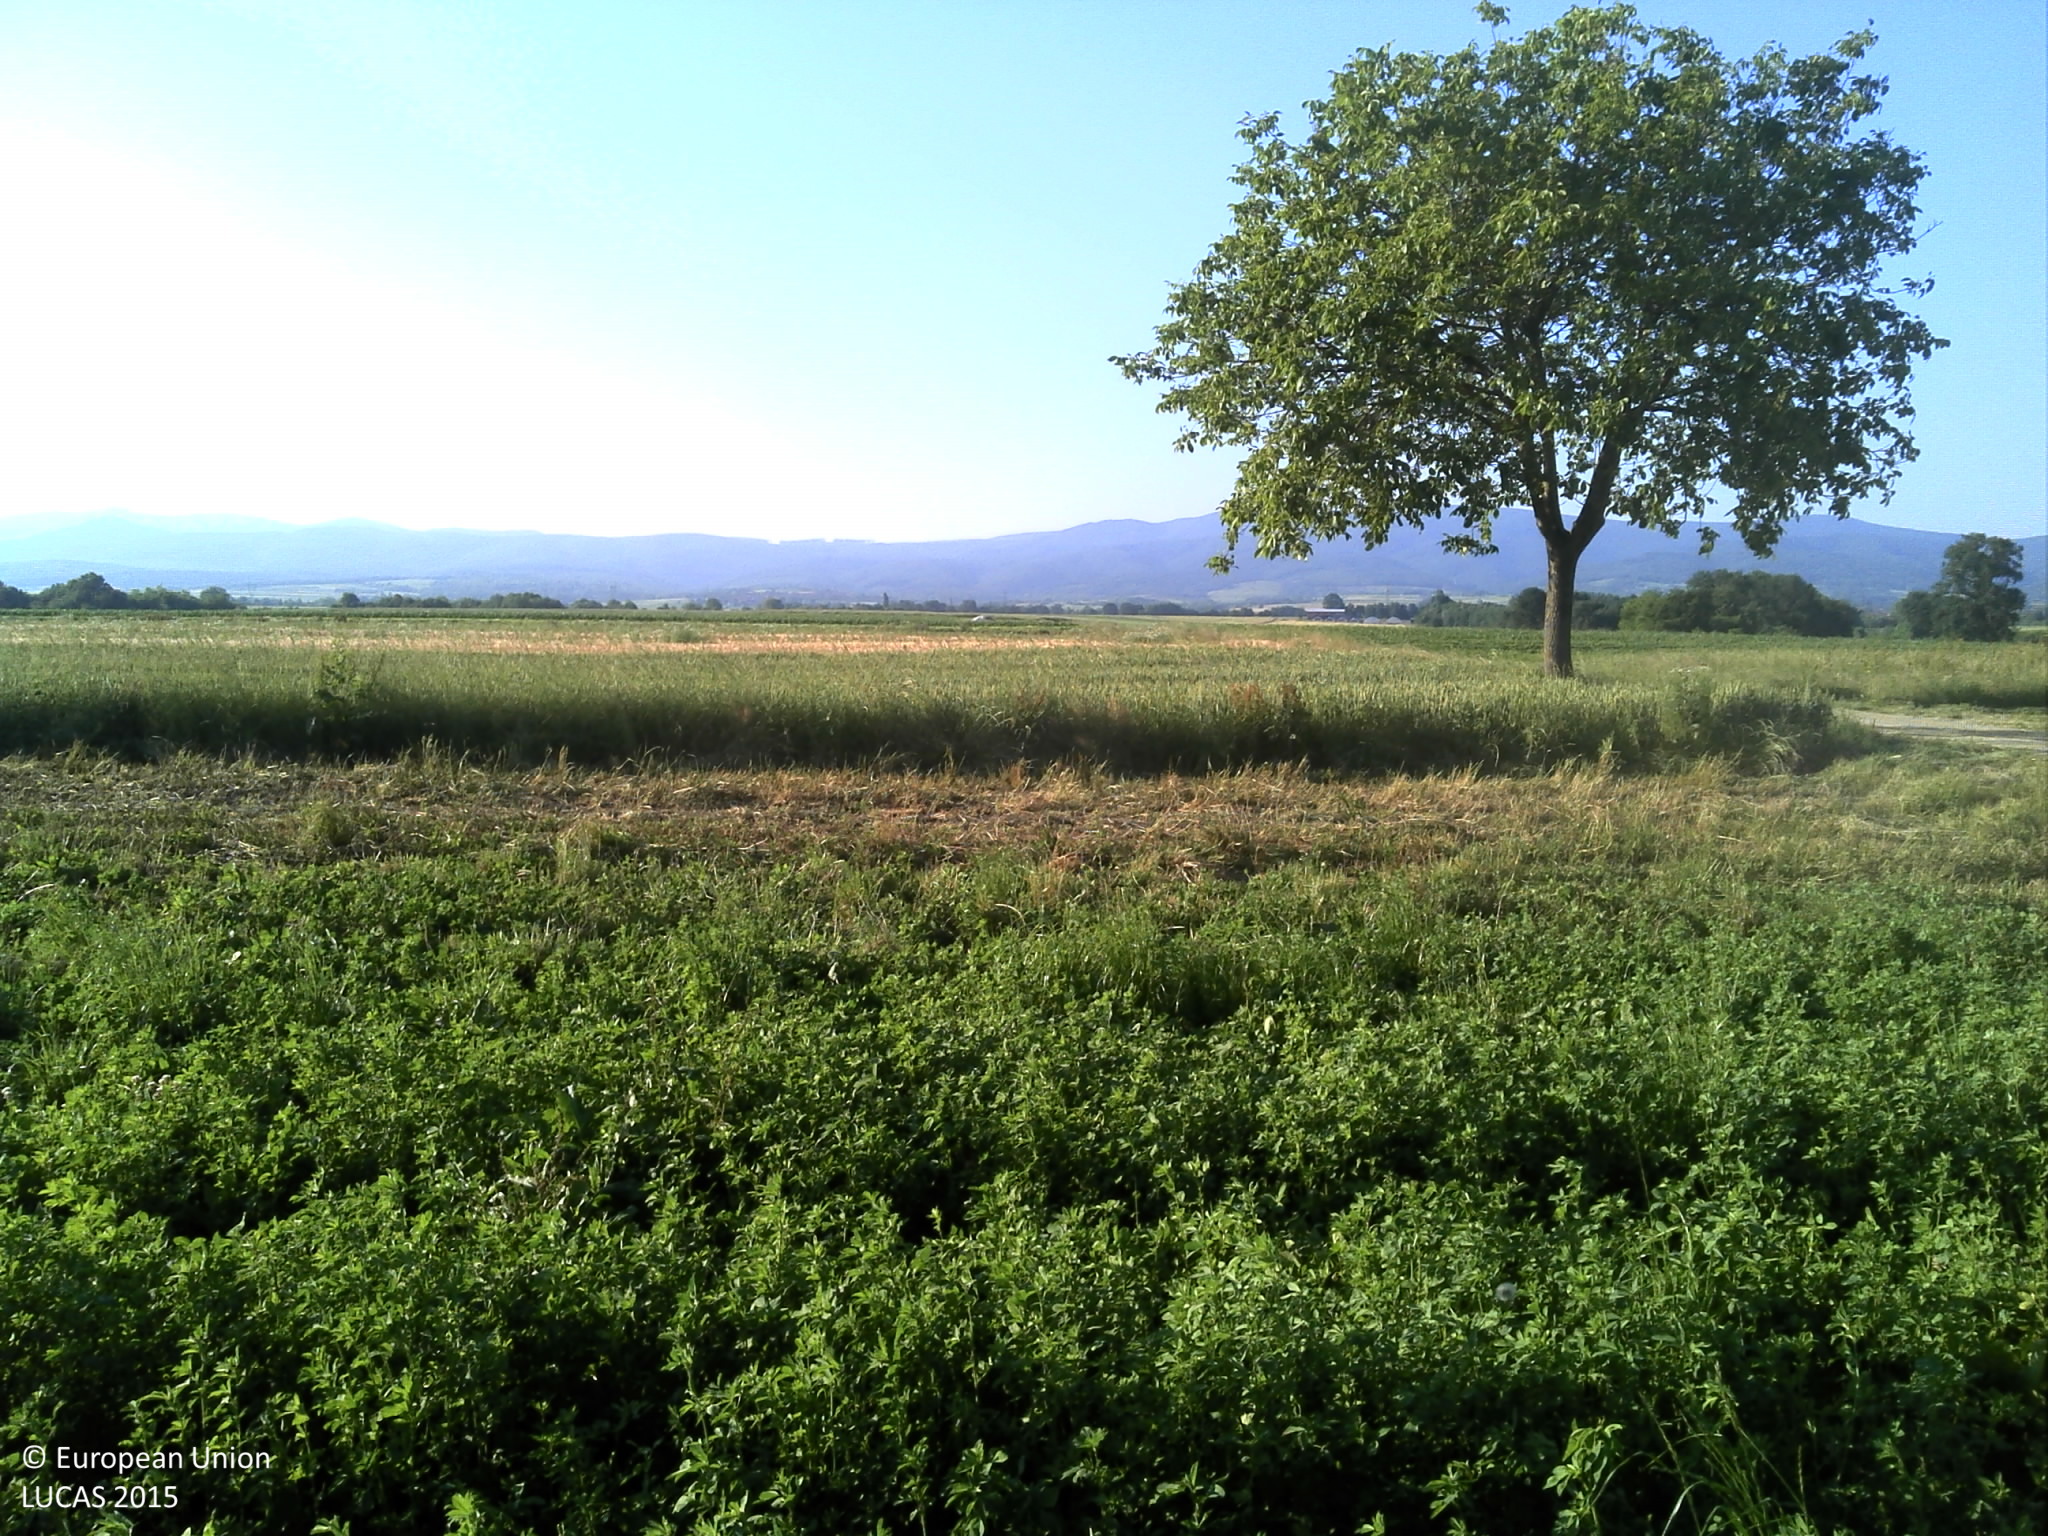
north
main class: Cropland
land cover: Clovers
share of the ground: 50 - 75 %
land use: Agriculture (excluding fallow land and kitchen gardens)
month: June
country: HR
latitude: 45.4035
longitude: 17.7058
